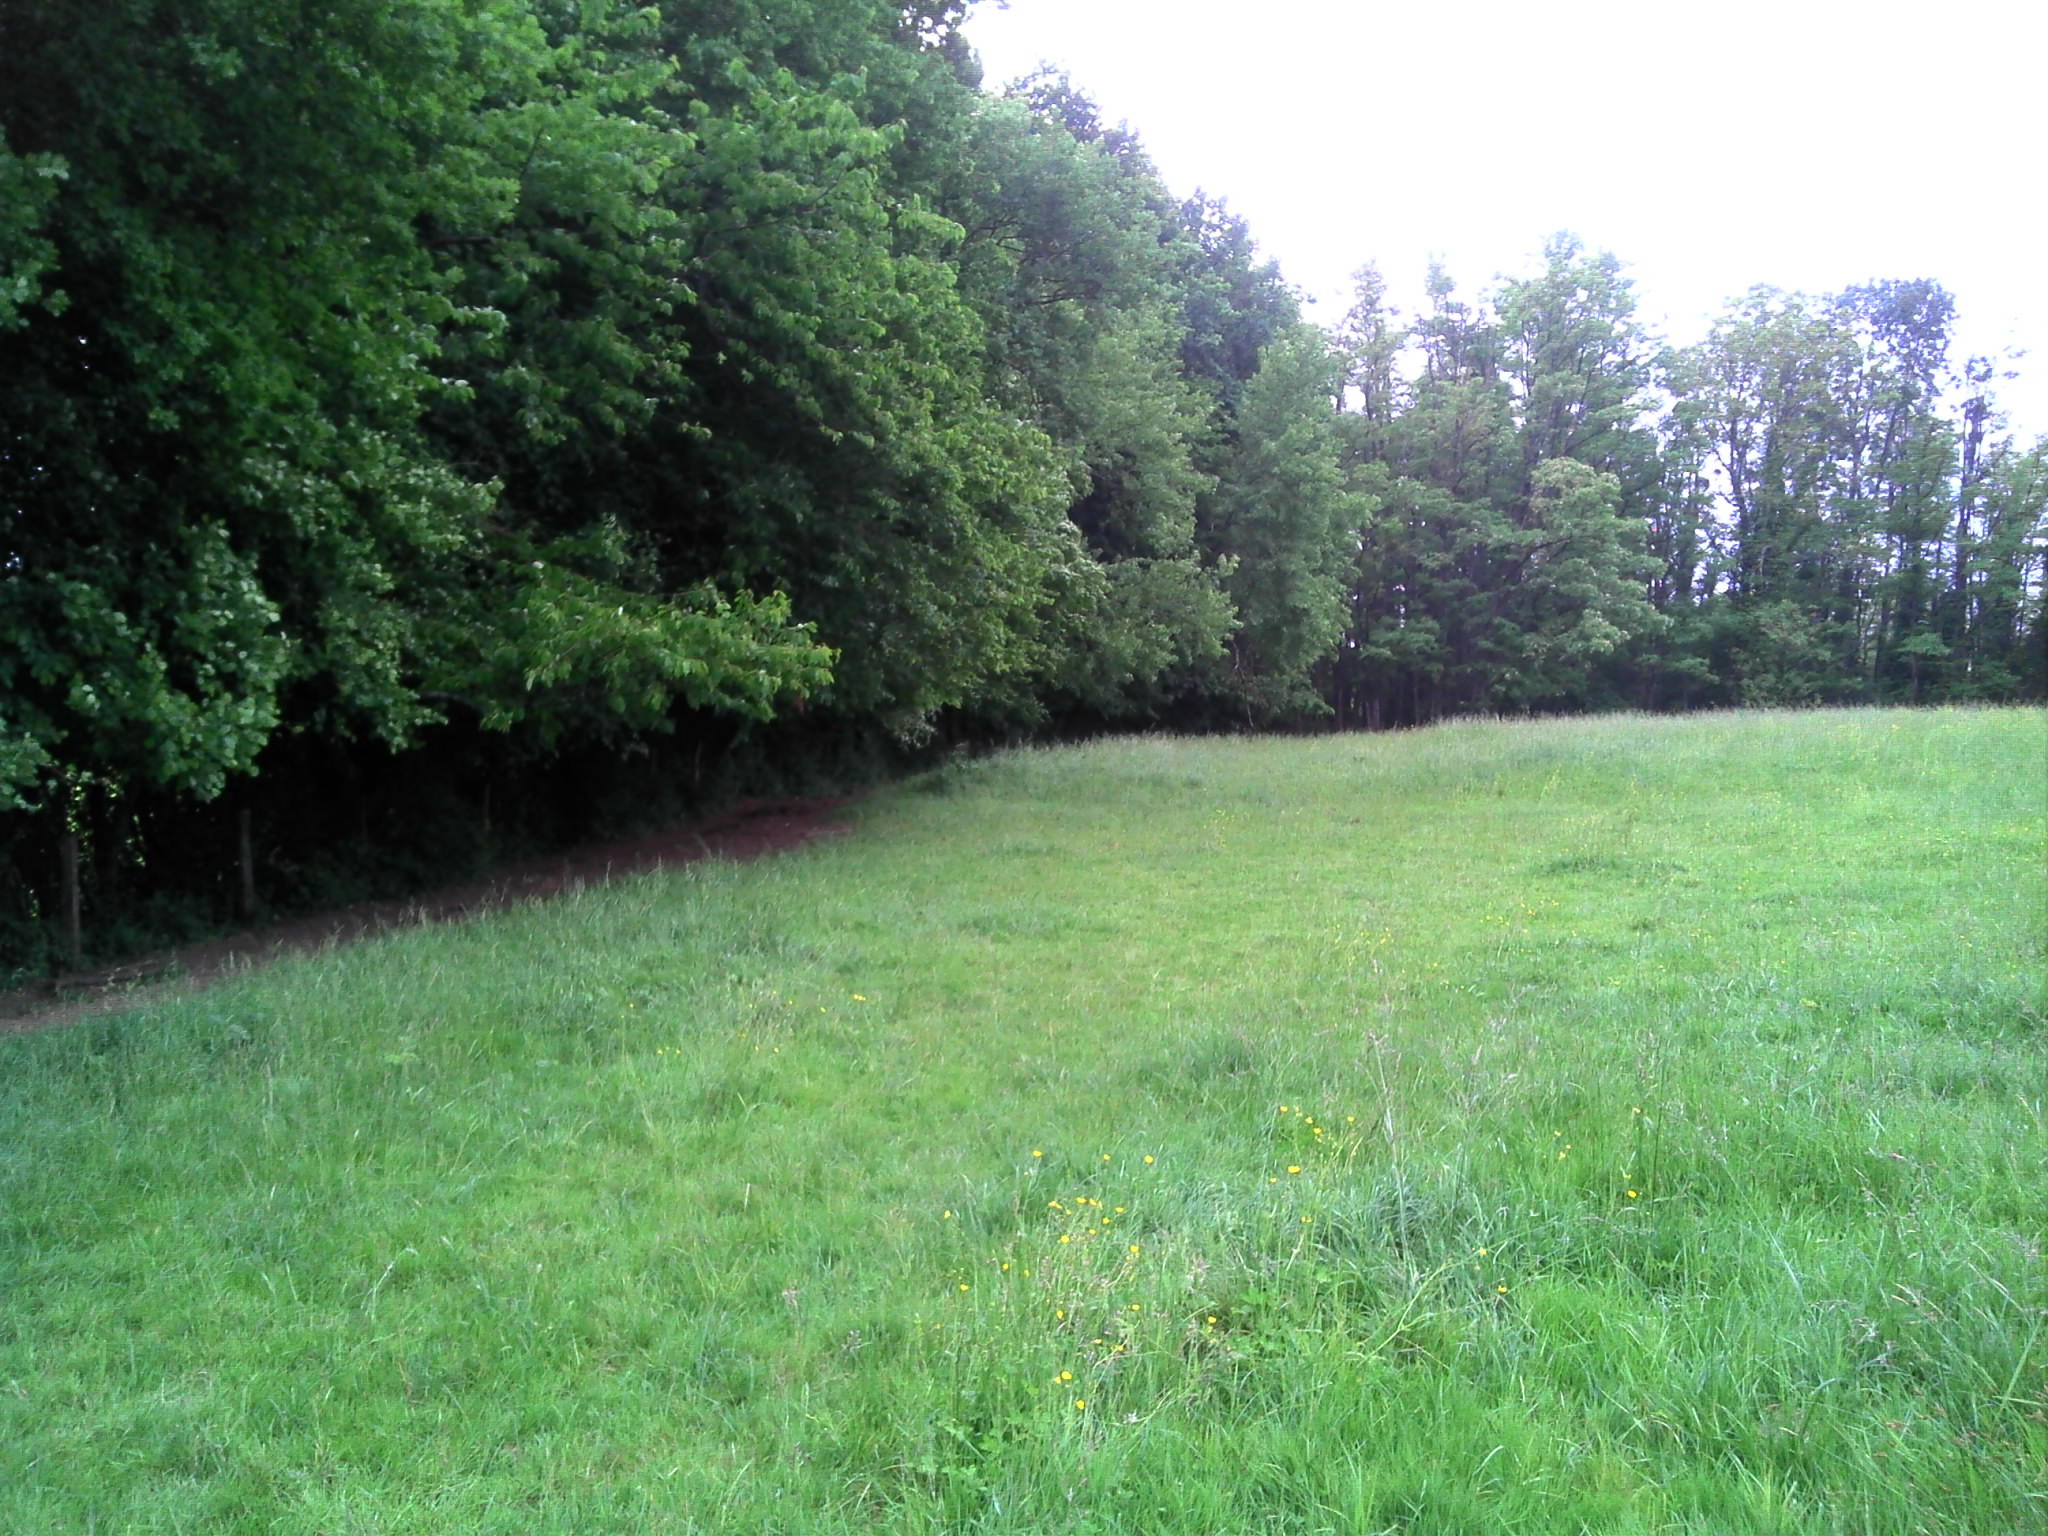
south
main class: Grassland
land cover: Grassland without tree/shrub cover
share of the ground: > 75 %
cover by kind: herbaceous plants 100 %
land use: Agriculture (excluding fallow land and kitchen gardens)
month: May
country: FR
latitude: 46.5386
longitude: 5.3473
